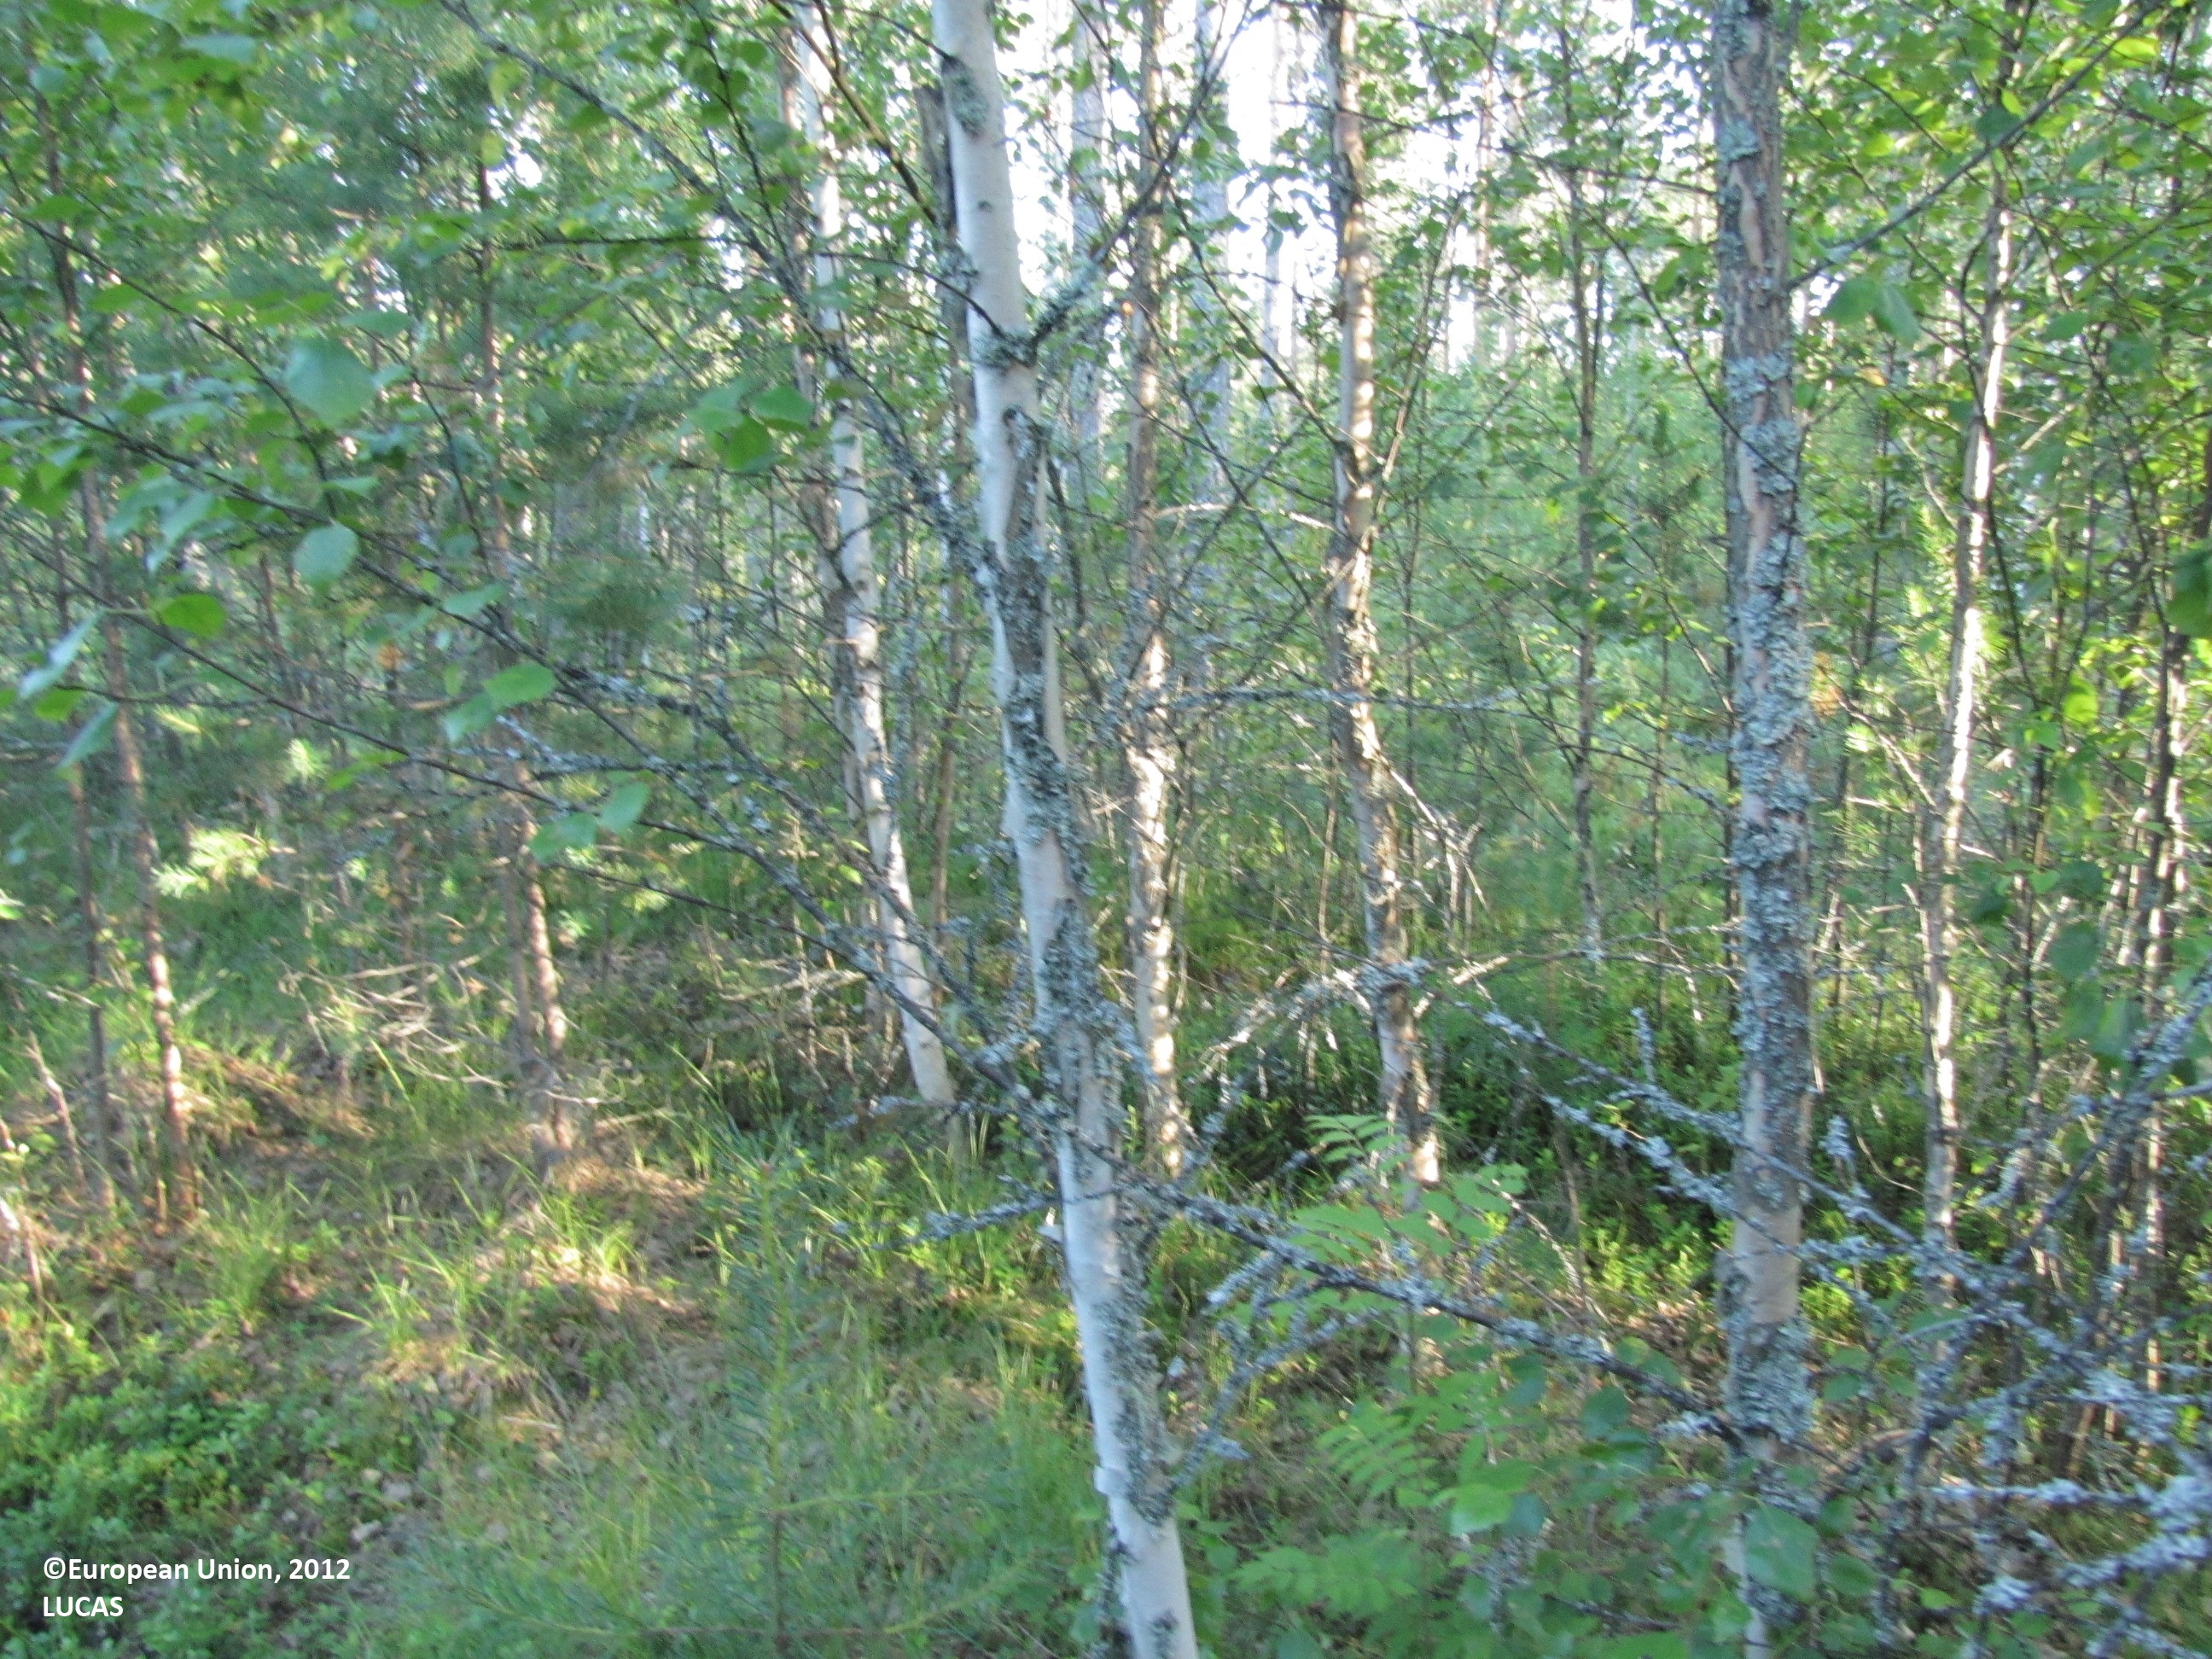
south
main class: Woodland
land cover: Broadleaved woodland
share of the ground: 25 - 50 %
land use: Forestry
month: July
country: FI
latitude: 62.5104
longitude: 23.1342
